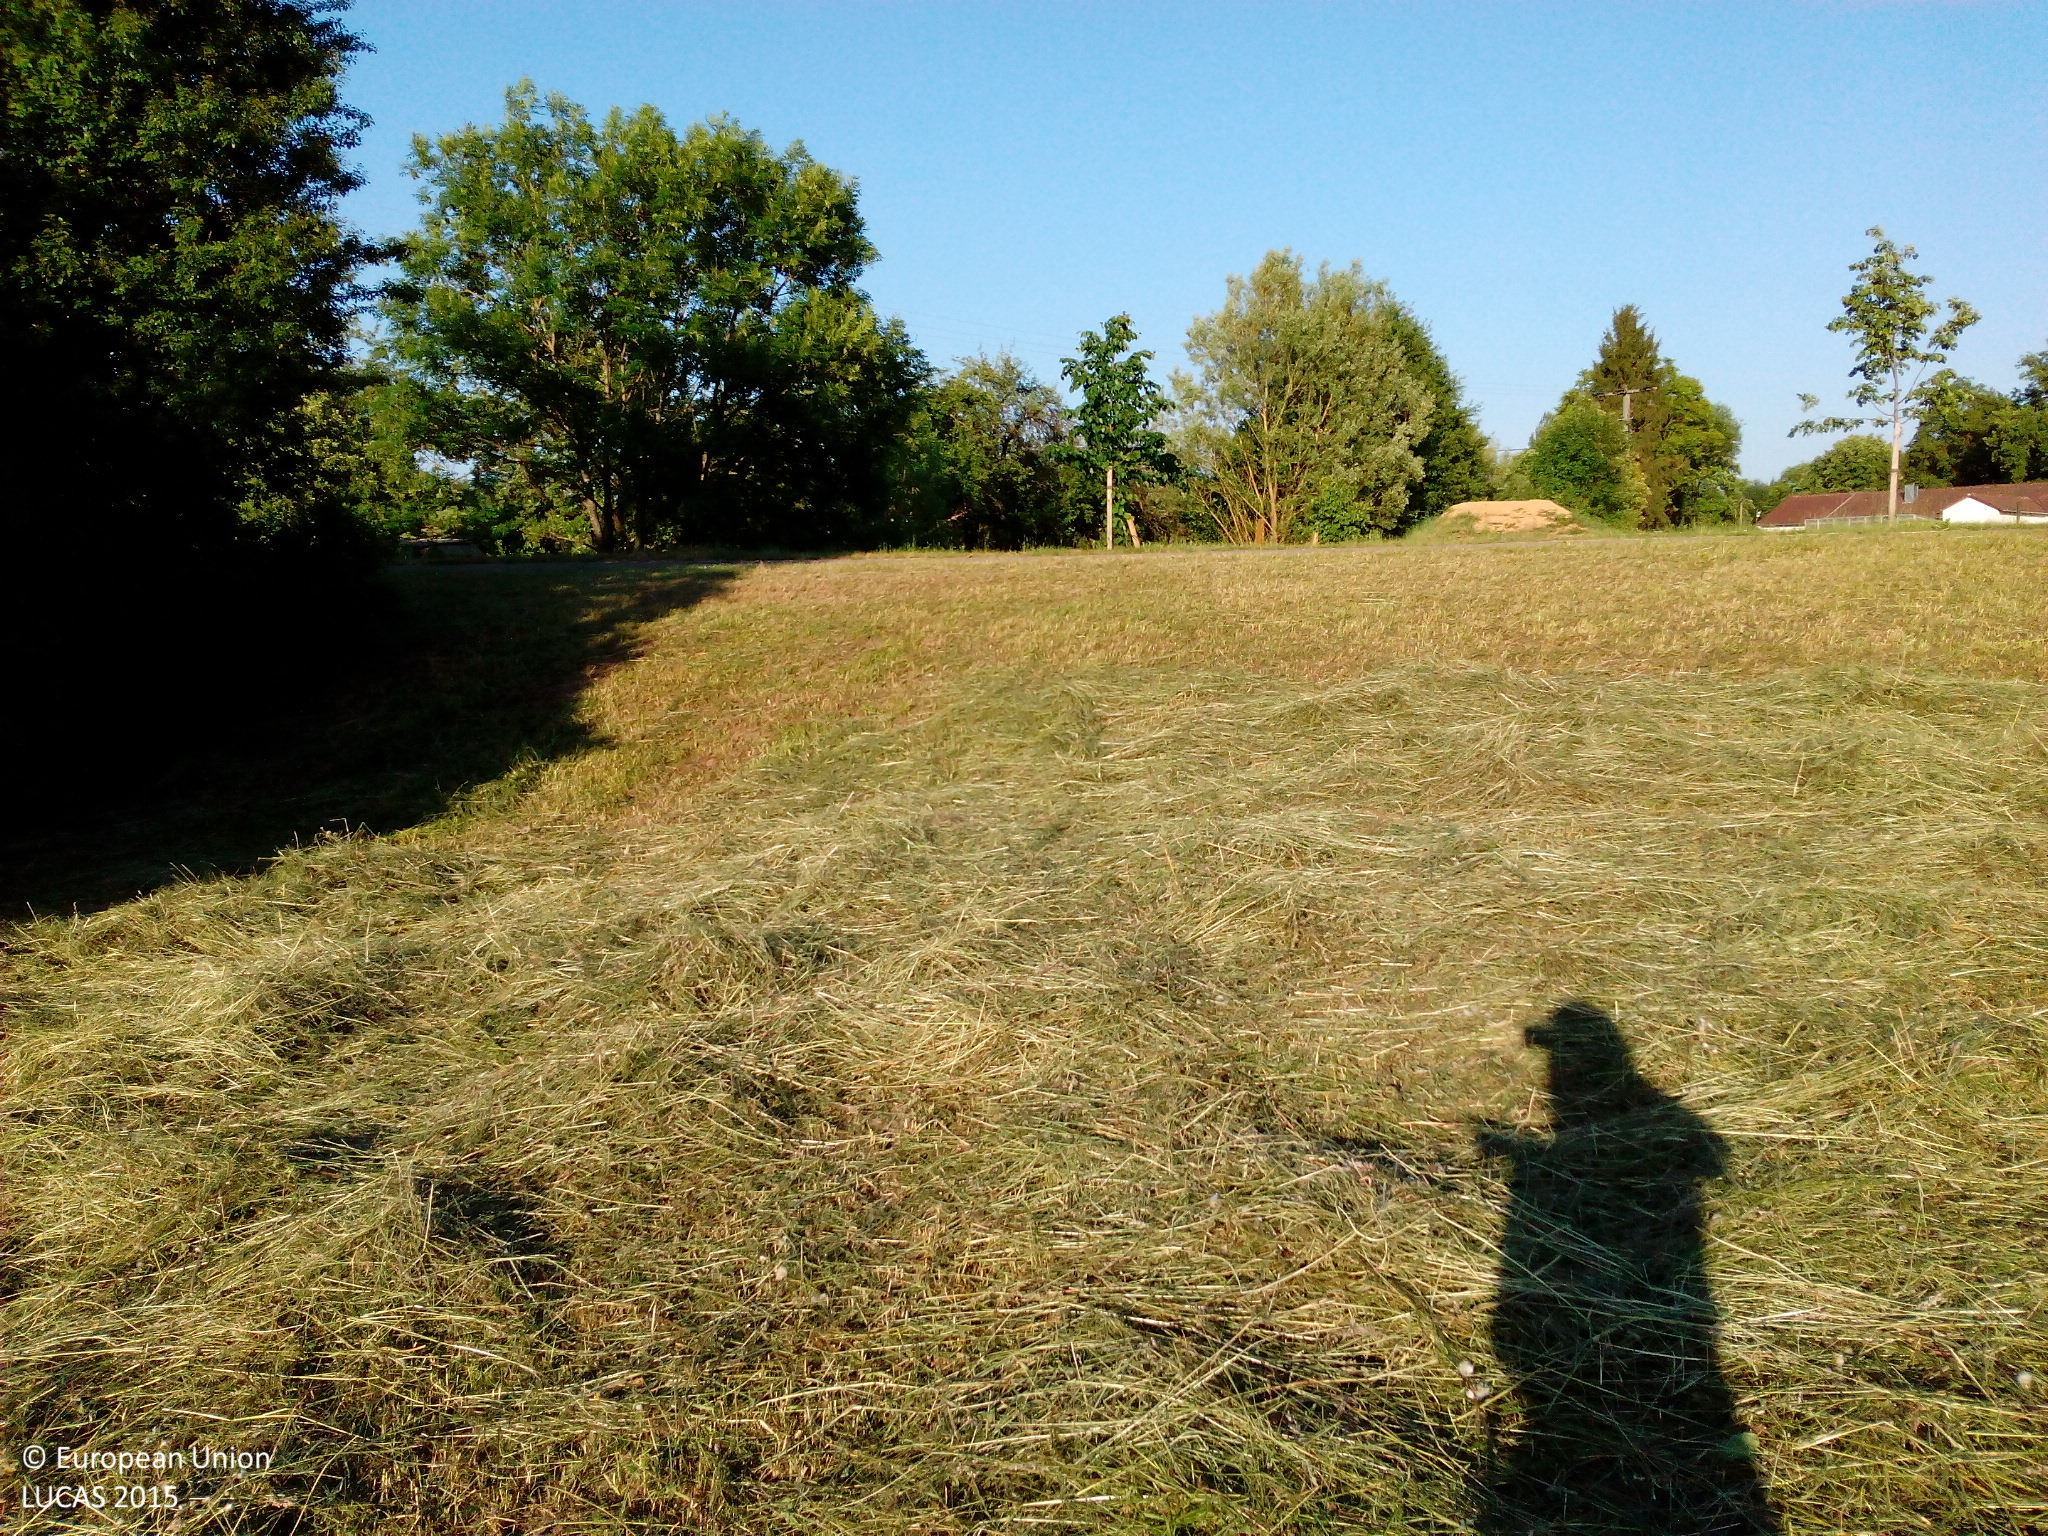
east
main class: Grassland
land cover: Grassland without tree/shrub cover
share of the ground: > 75 %
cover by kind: herbaceous plants 100 %
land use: Agriculture (excluding fallow land and kitchen gardens)
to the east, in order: Grassland without tree/shrub cover; Paved roads, cycling and walking lanes; Grassland with sparse tree/shrub cover; Ditches and canals; Apple fruit; Electric lines; Apple fruit; Tracks; Rape and turnip rape; Electric lines; Rape and turnip rape
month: June
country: DE
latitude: 48.9235
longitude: 9.3861
